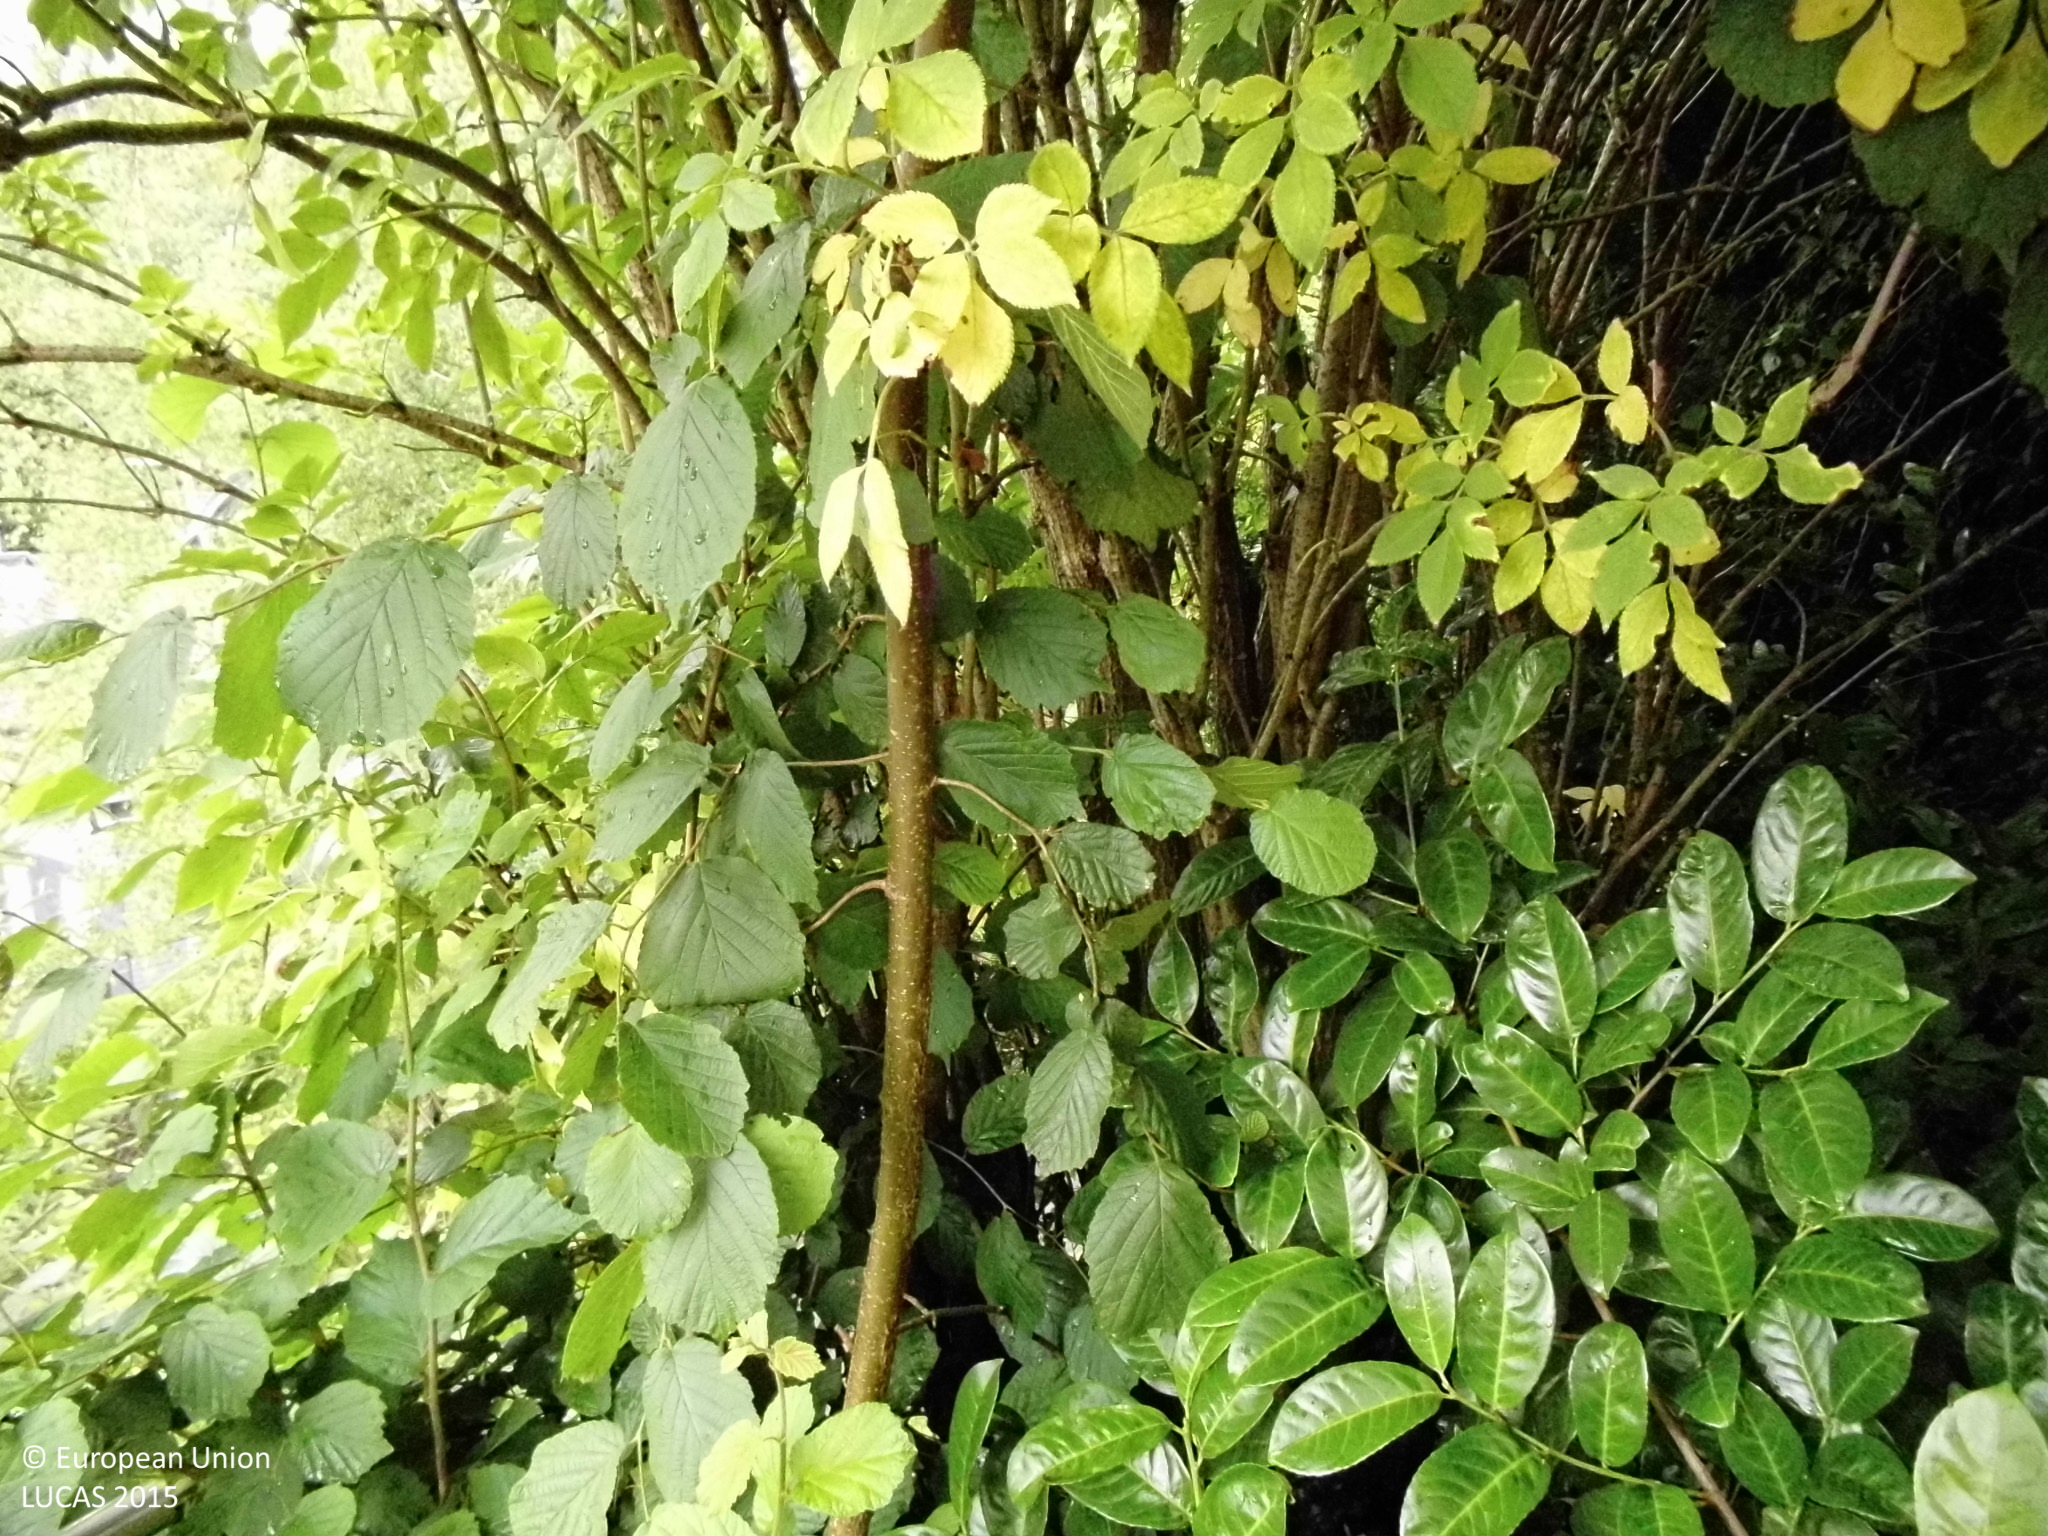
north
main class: Woodland
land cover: Broadleaved woodland
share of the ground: > 75 %
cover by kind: broadleaved forest trees 80 %, coniferous forest trees 20 %
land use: Residential
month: July
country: DE
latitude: 50.8322
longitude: 7.9984
